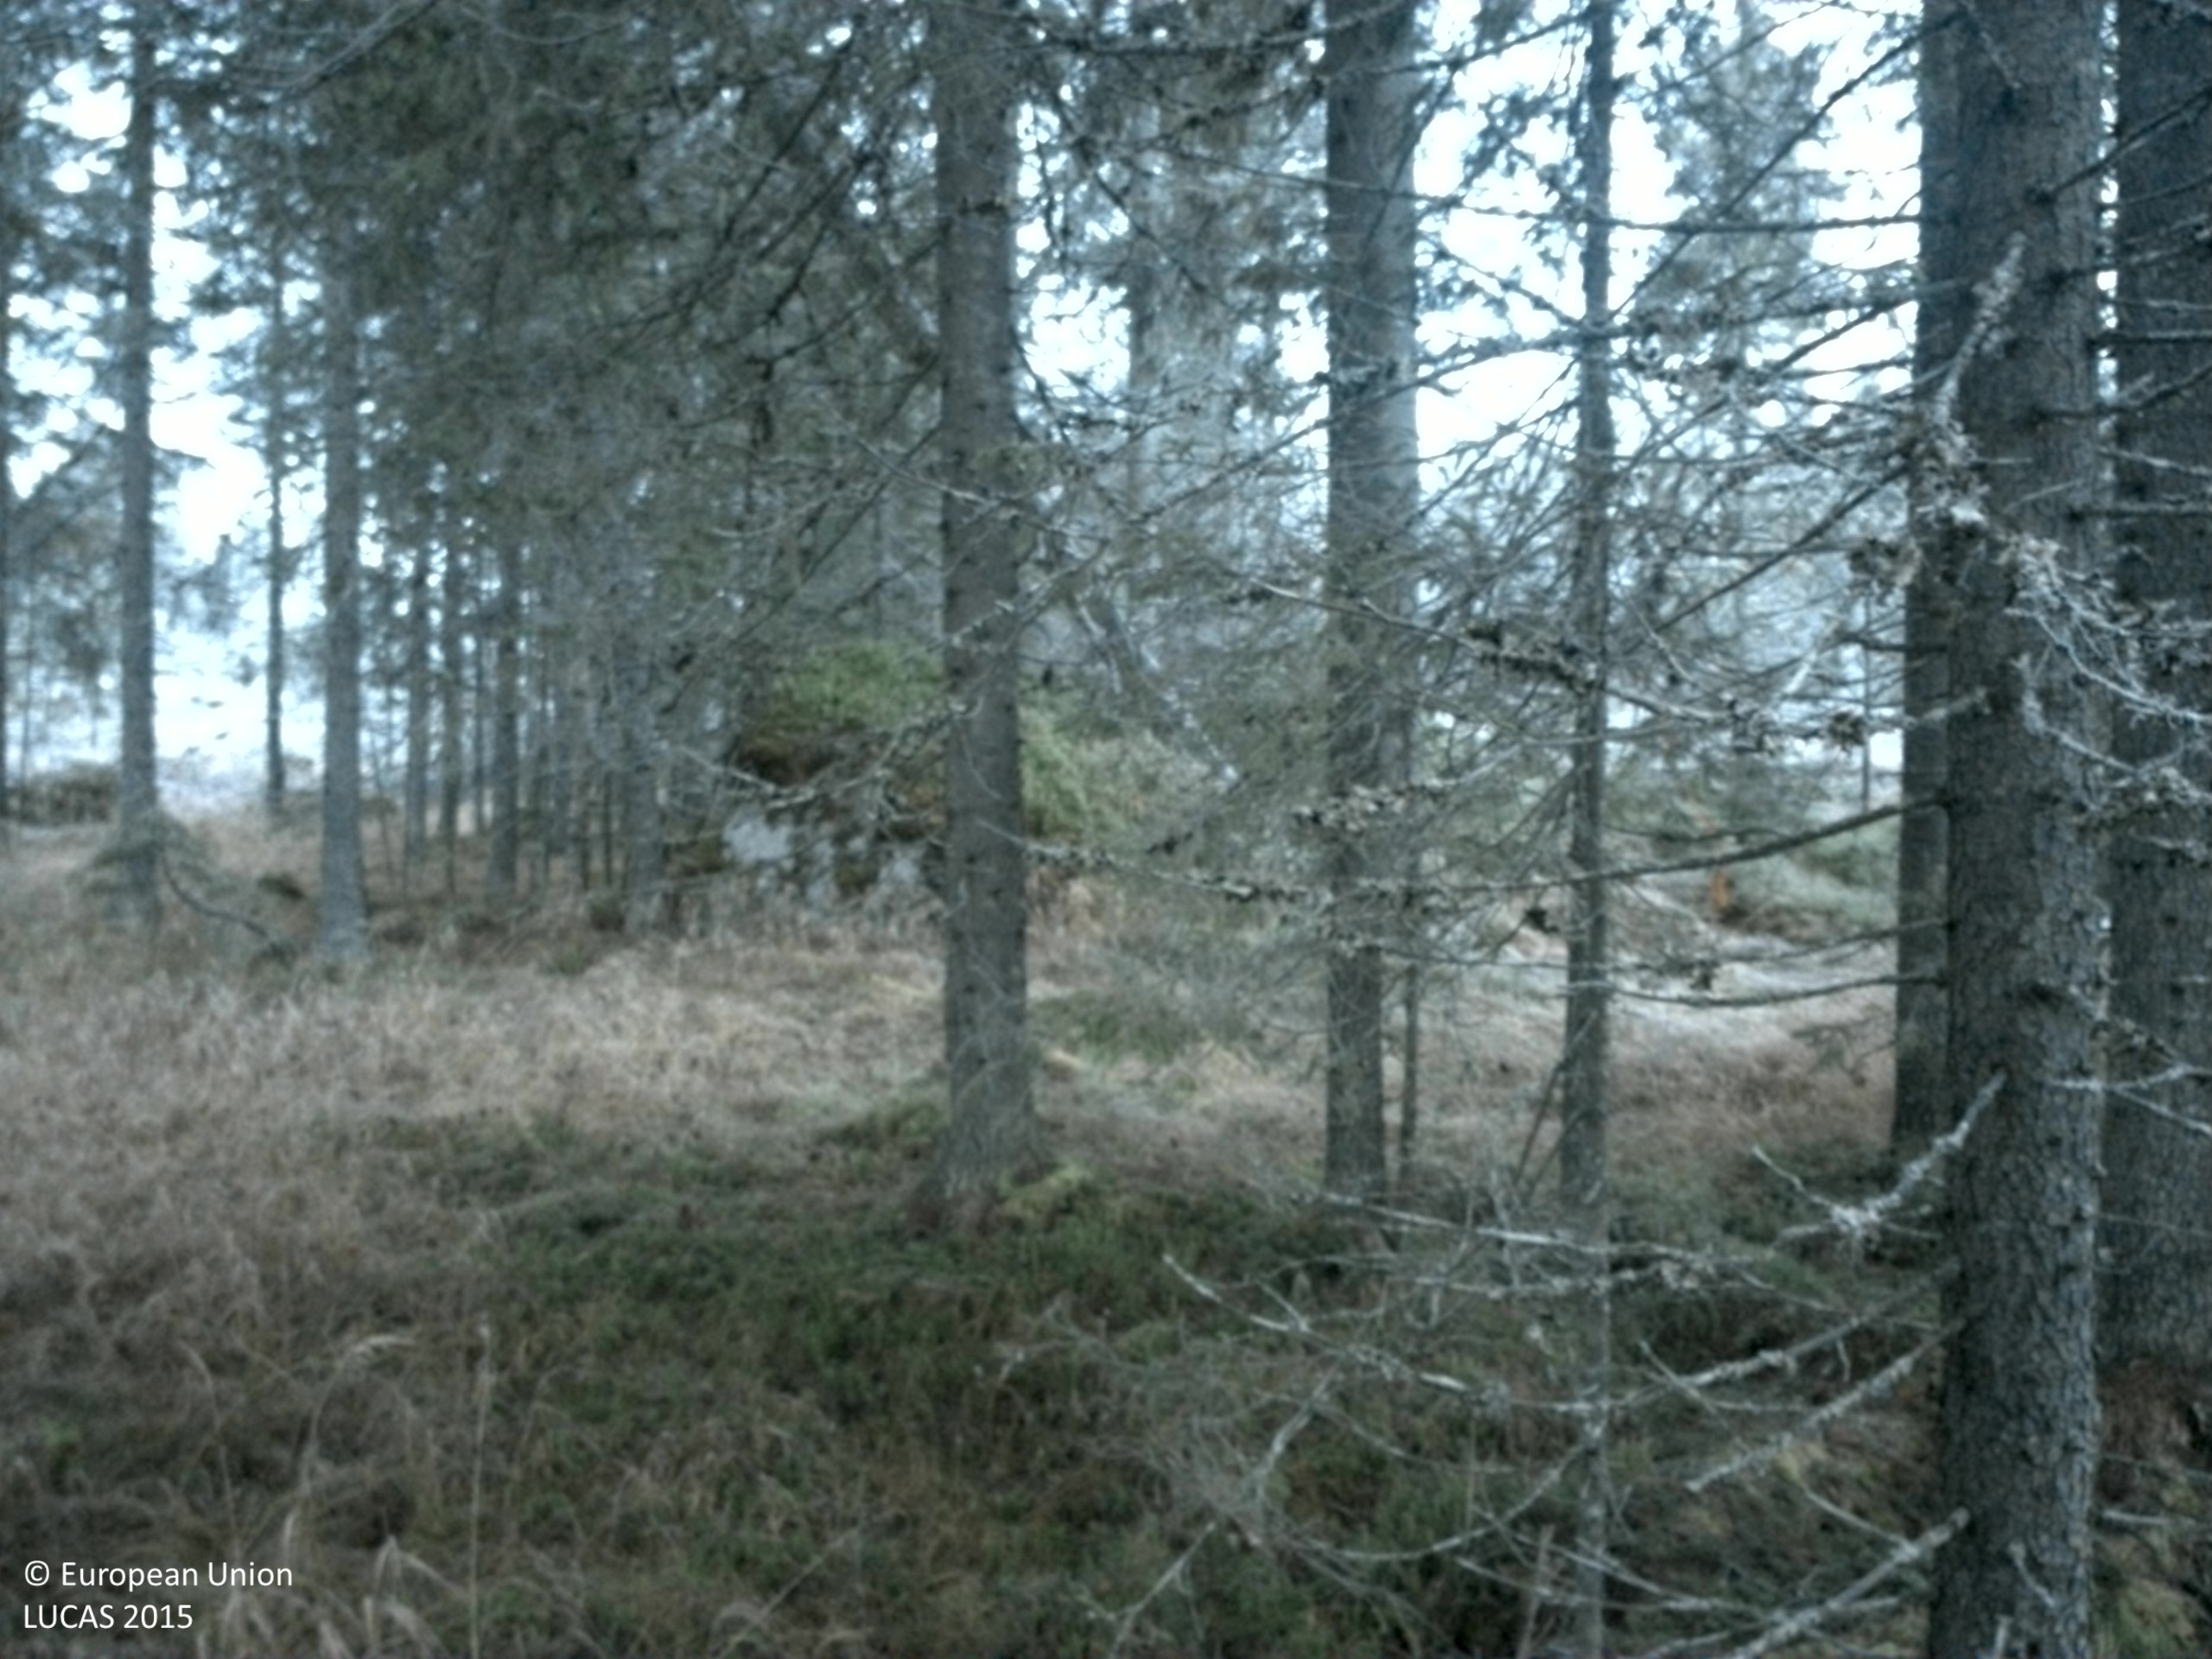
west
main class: Woodland
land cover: Spruce dominated coniferous woodland
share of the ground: 25 - 50 %
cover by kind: herbaceous plants 35 %, coniferous forest trees 20 %, lichens and mosses 20 %, shrubs 15 %, broadleaved forest trees 5 %
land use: Forestry
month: November
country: SE
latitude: 63.7823
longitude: 15.8769
